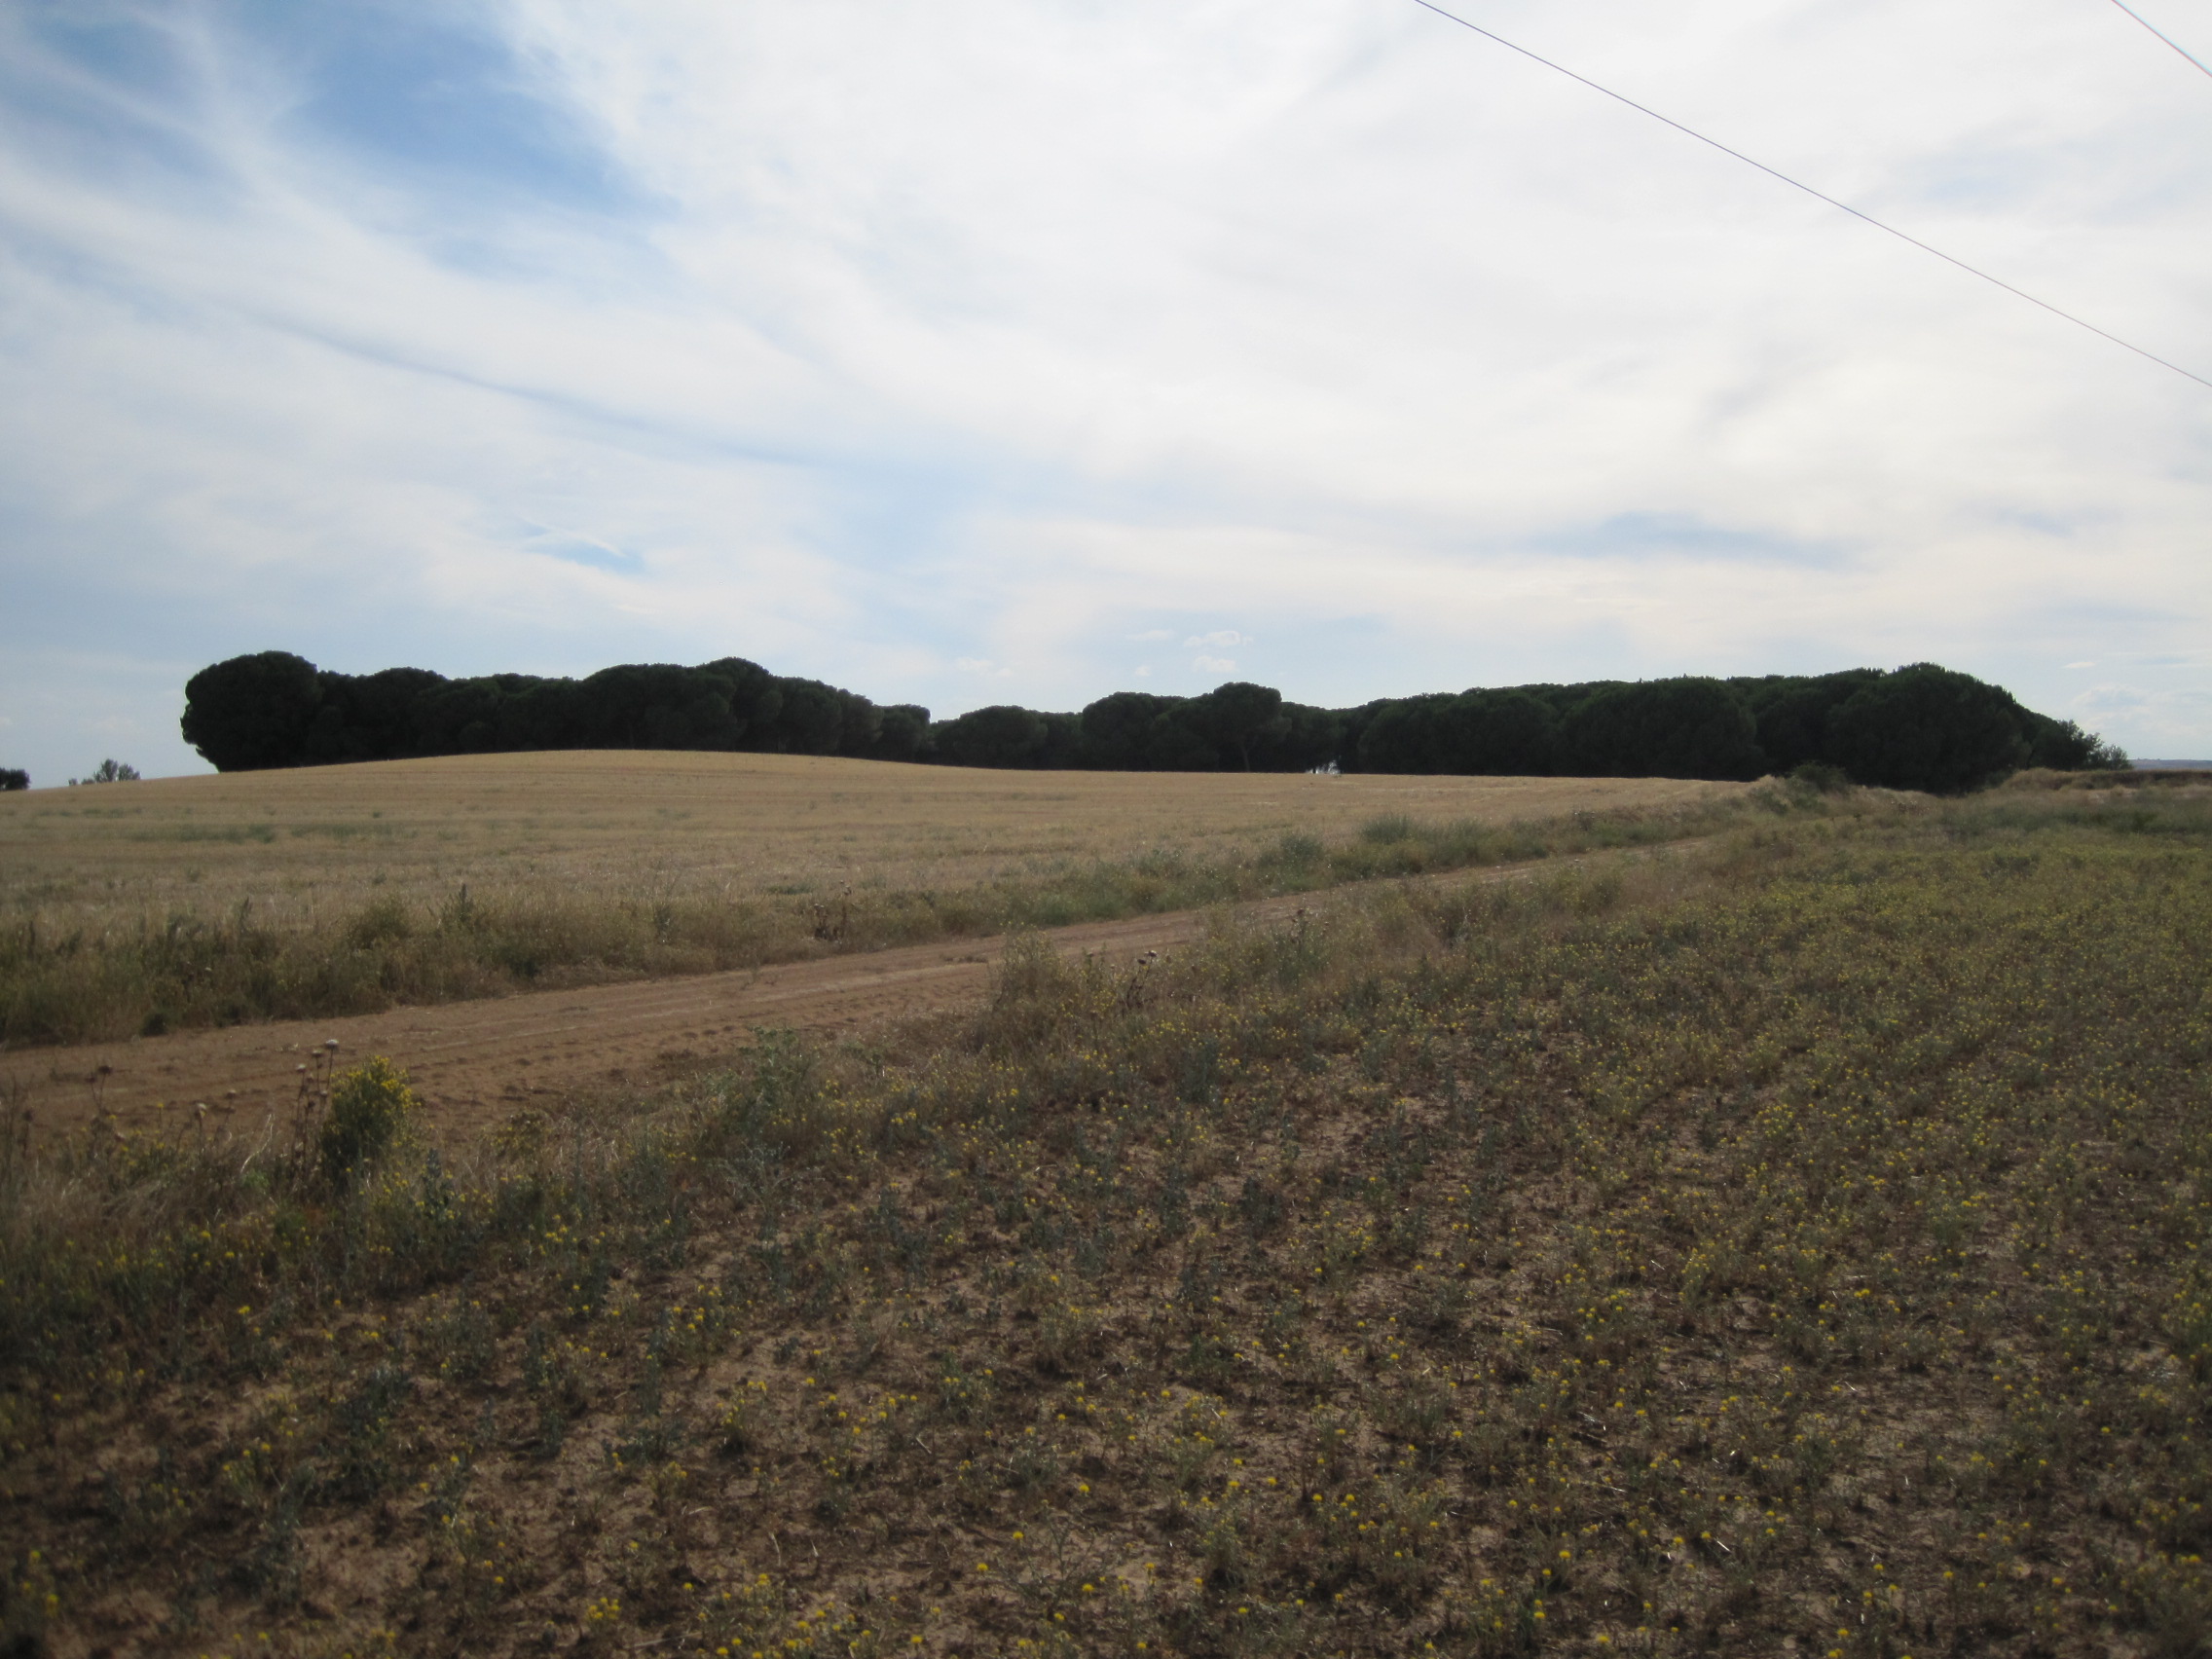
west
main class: Cropland
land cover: Dry pulses
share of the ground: < 10 %
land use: Agriculture (excluding fallow land and kitchen gardens)
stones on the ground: < 10 %
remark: Harvested field
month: July
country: ES
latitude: 41.9647
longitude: -5.2745
